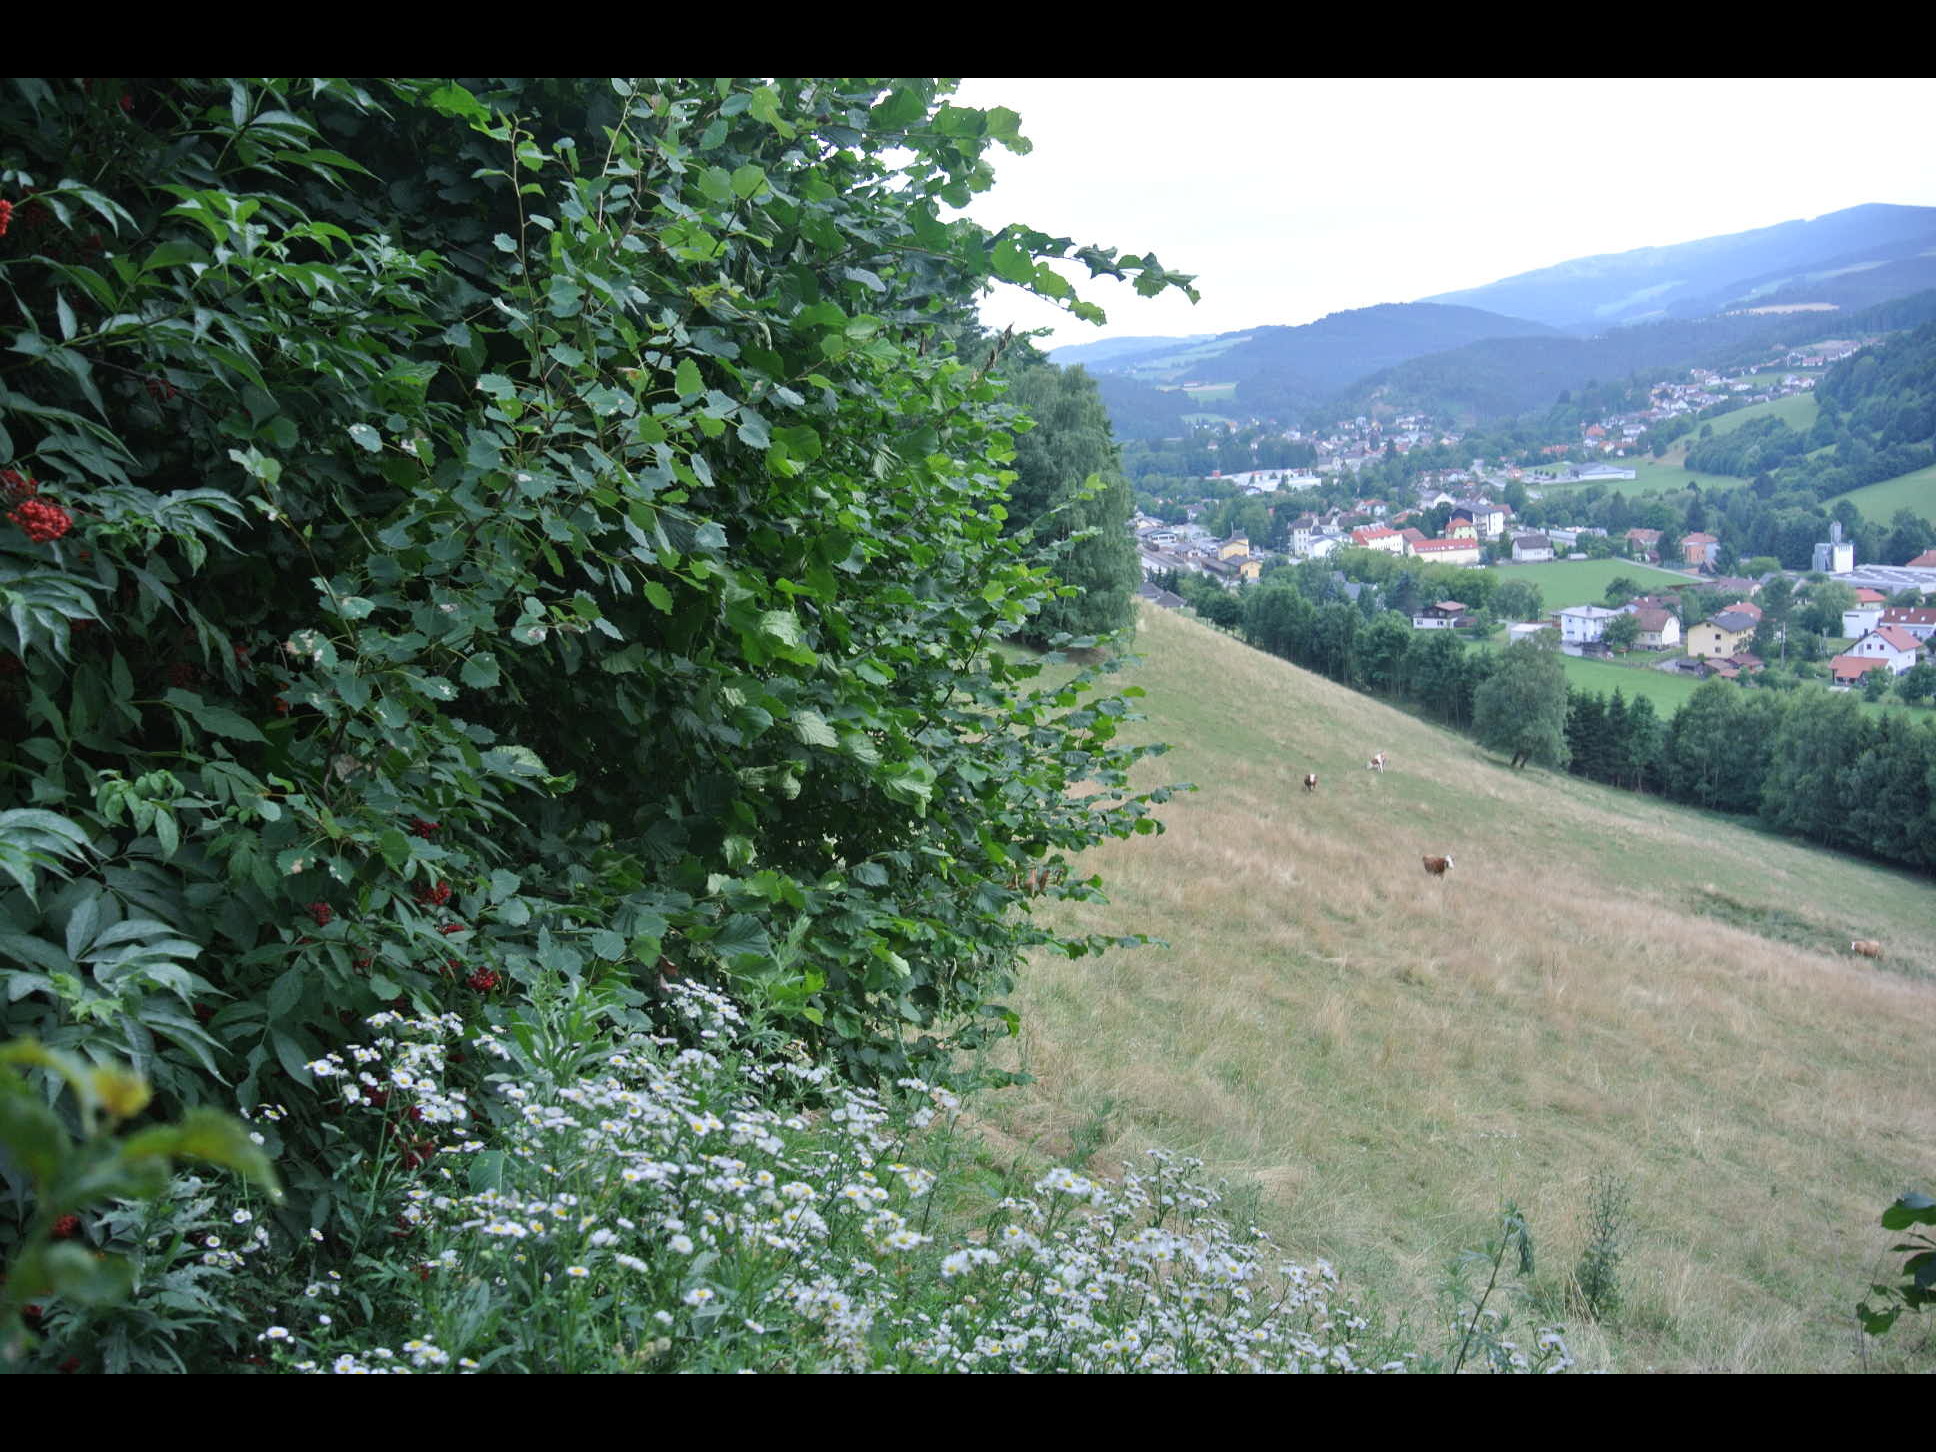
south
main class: Grassland
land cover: Grassland without tree/shrub cover
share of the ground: > 75 %
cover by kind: herbaceous plants 100 %
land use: Agriculture (excluding fallow land and kitchen gardens)
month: July
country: AT
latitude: 47.5671
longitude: 16.1038
